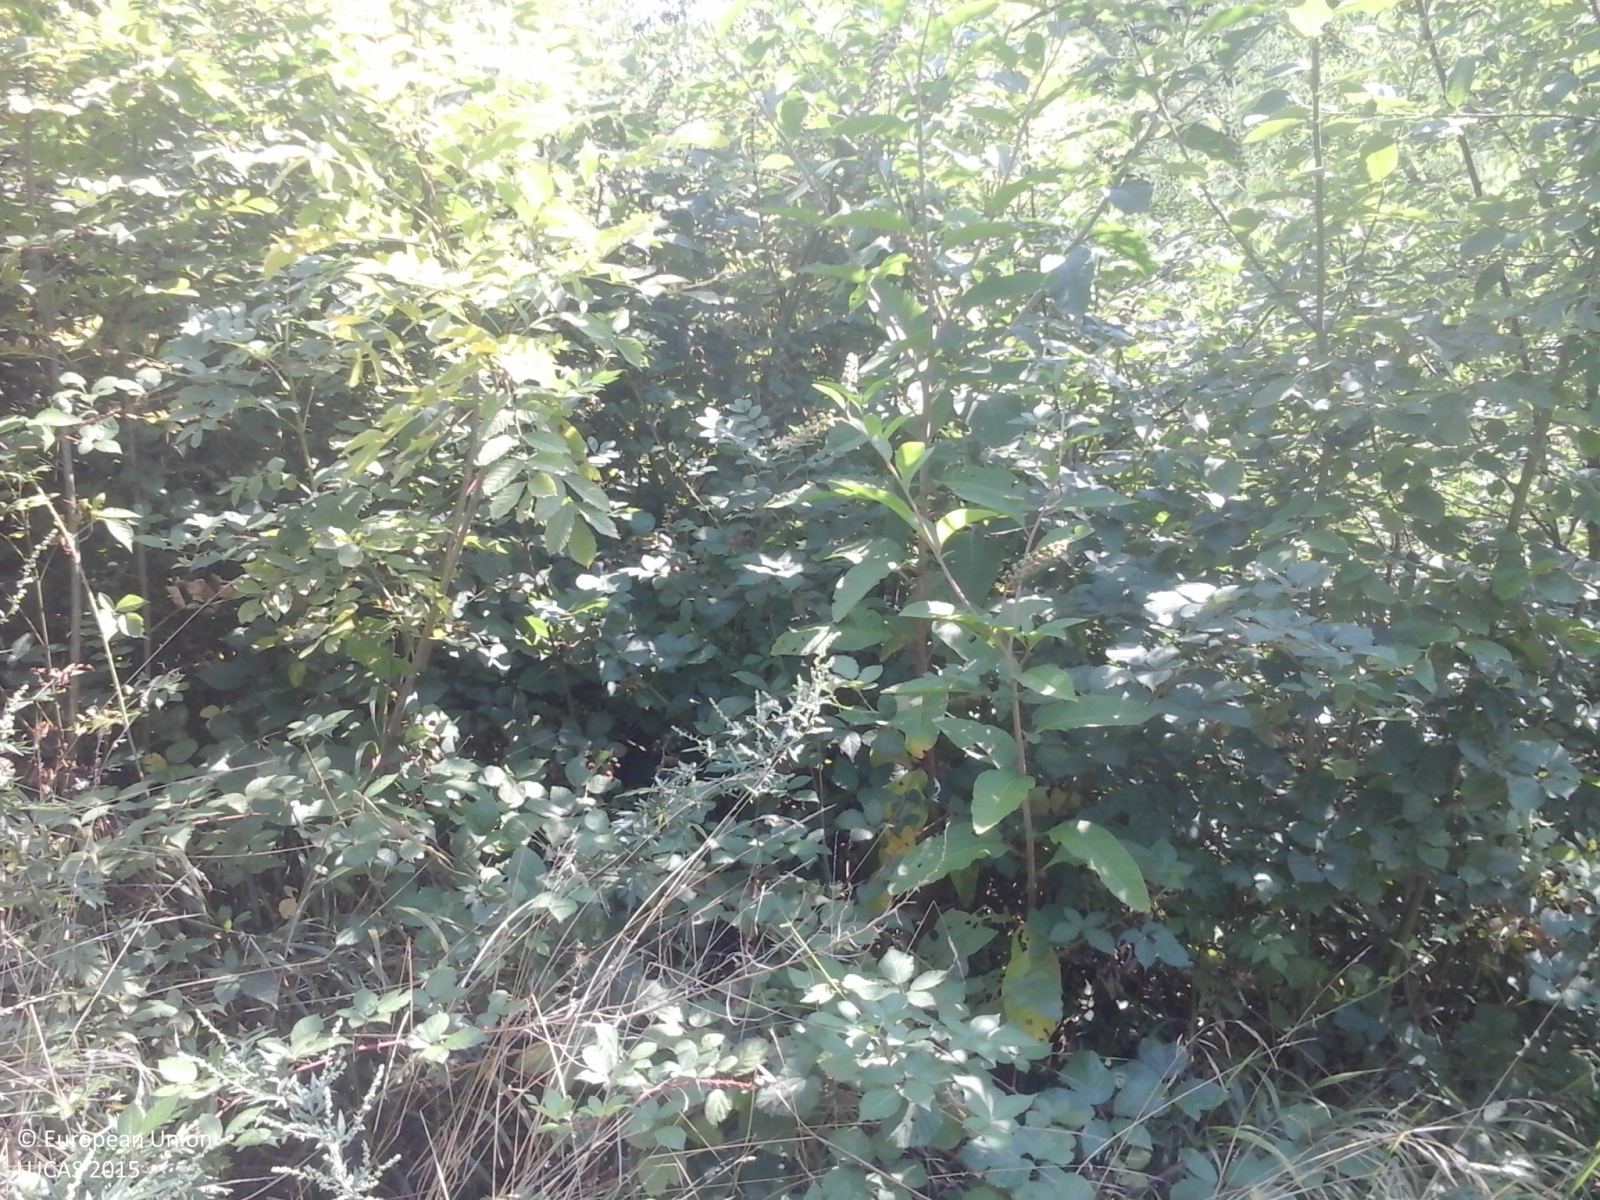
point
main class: Woodland
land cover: Broadleaved woodland
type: thermophilous deciduous forest
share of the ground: > 75 %
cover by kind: broadleaved forest trees 80 %, coniferous forest trees 10 %, shrubs 5 %, herbaceous plants 5 %
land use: Forestry
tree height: > 5 m
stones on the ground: > 50 %
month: August
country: IT
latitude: 46.0251
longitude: 9.3679
